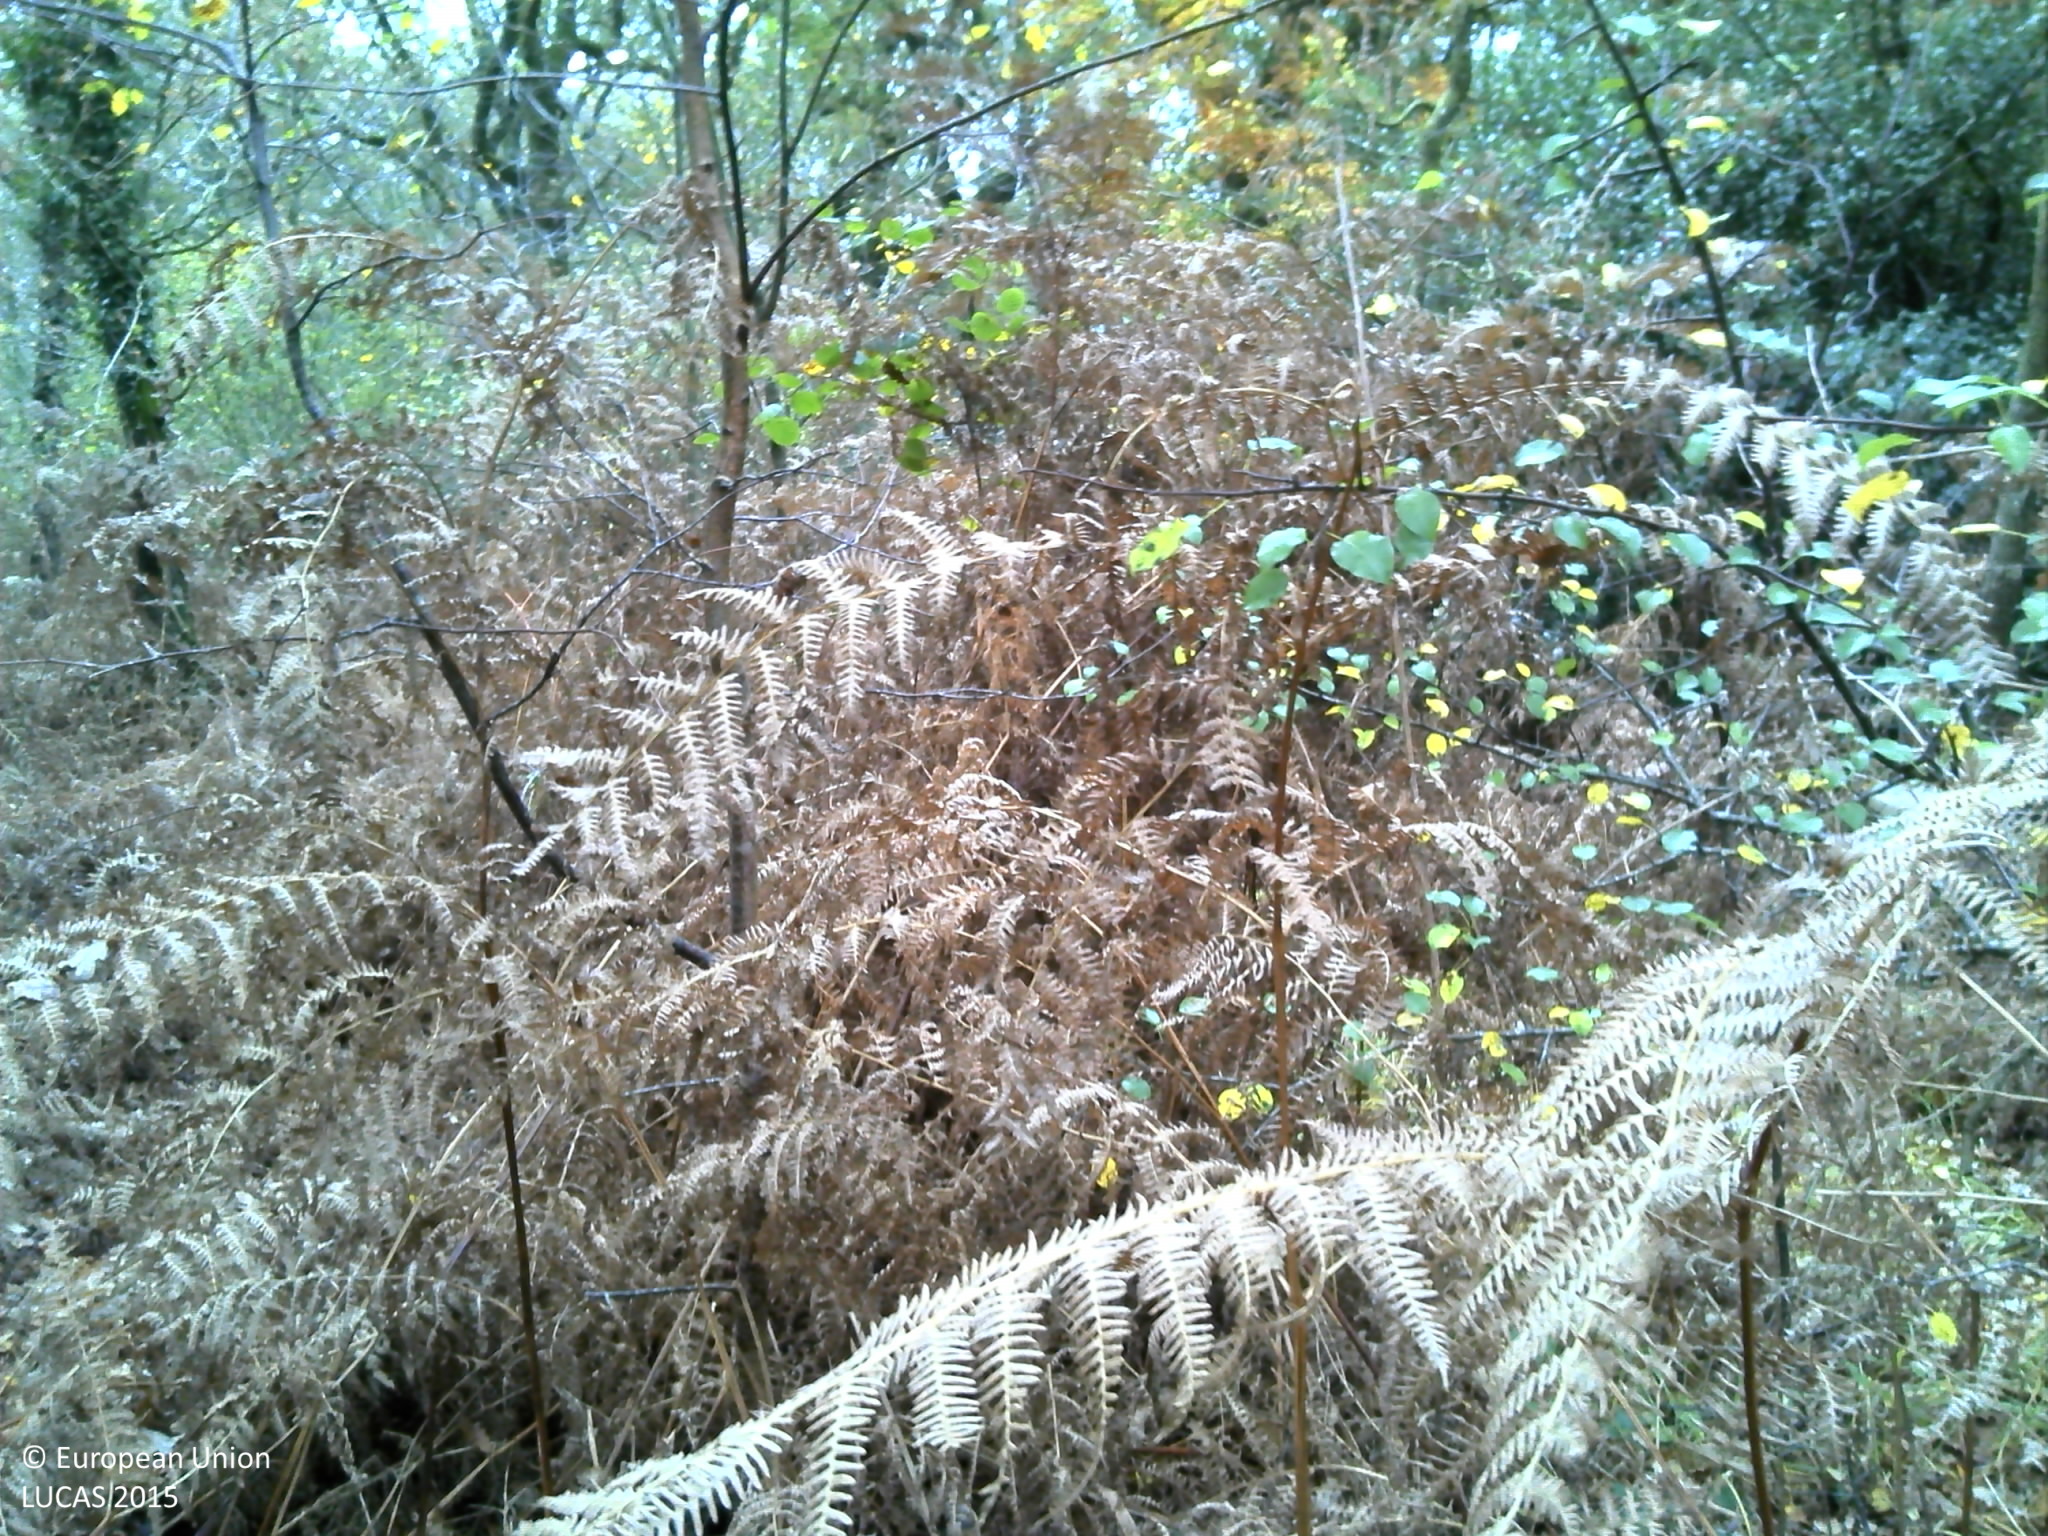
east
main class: Woodland
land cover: Broadleaved woodland
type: acidophilous oak and oak-birch forest
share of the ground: 50 - 75 %
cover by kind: broadleaved forest trees 70 %, herbaceous plants 30 %
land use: Forestry
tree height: > 5 m
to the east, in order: Broadleaved woodland; Ditches and canals; Broadleaved woodland
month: November
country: FR
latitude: 47.6512
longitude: -1.3716
